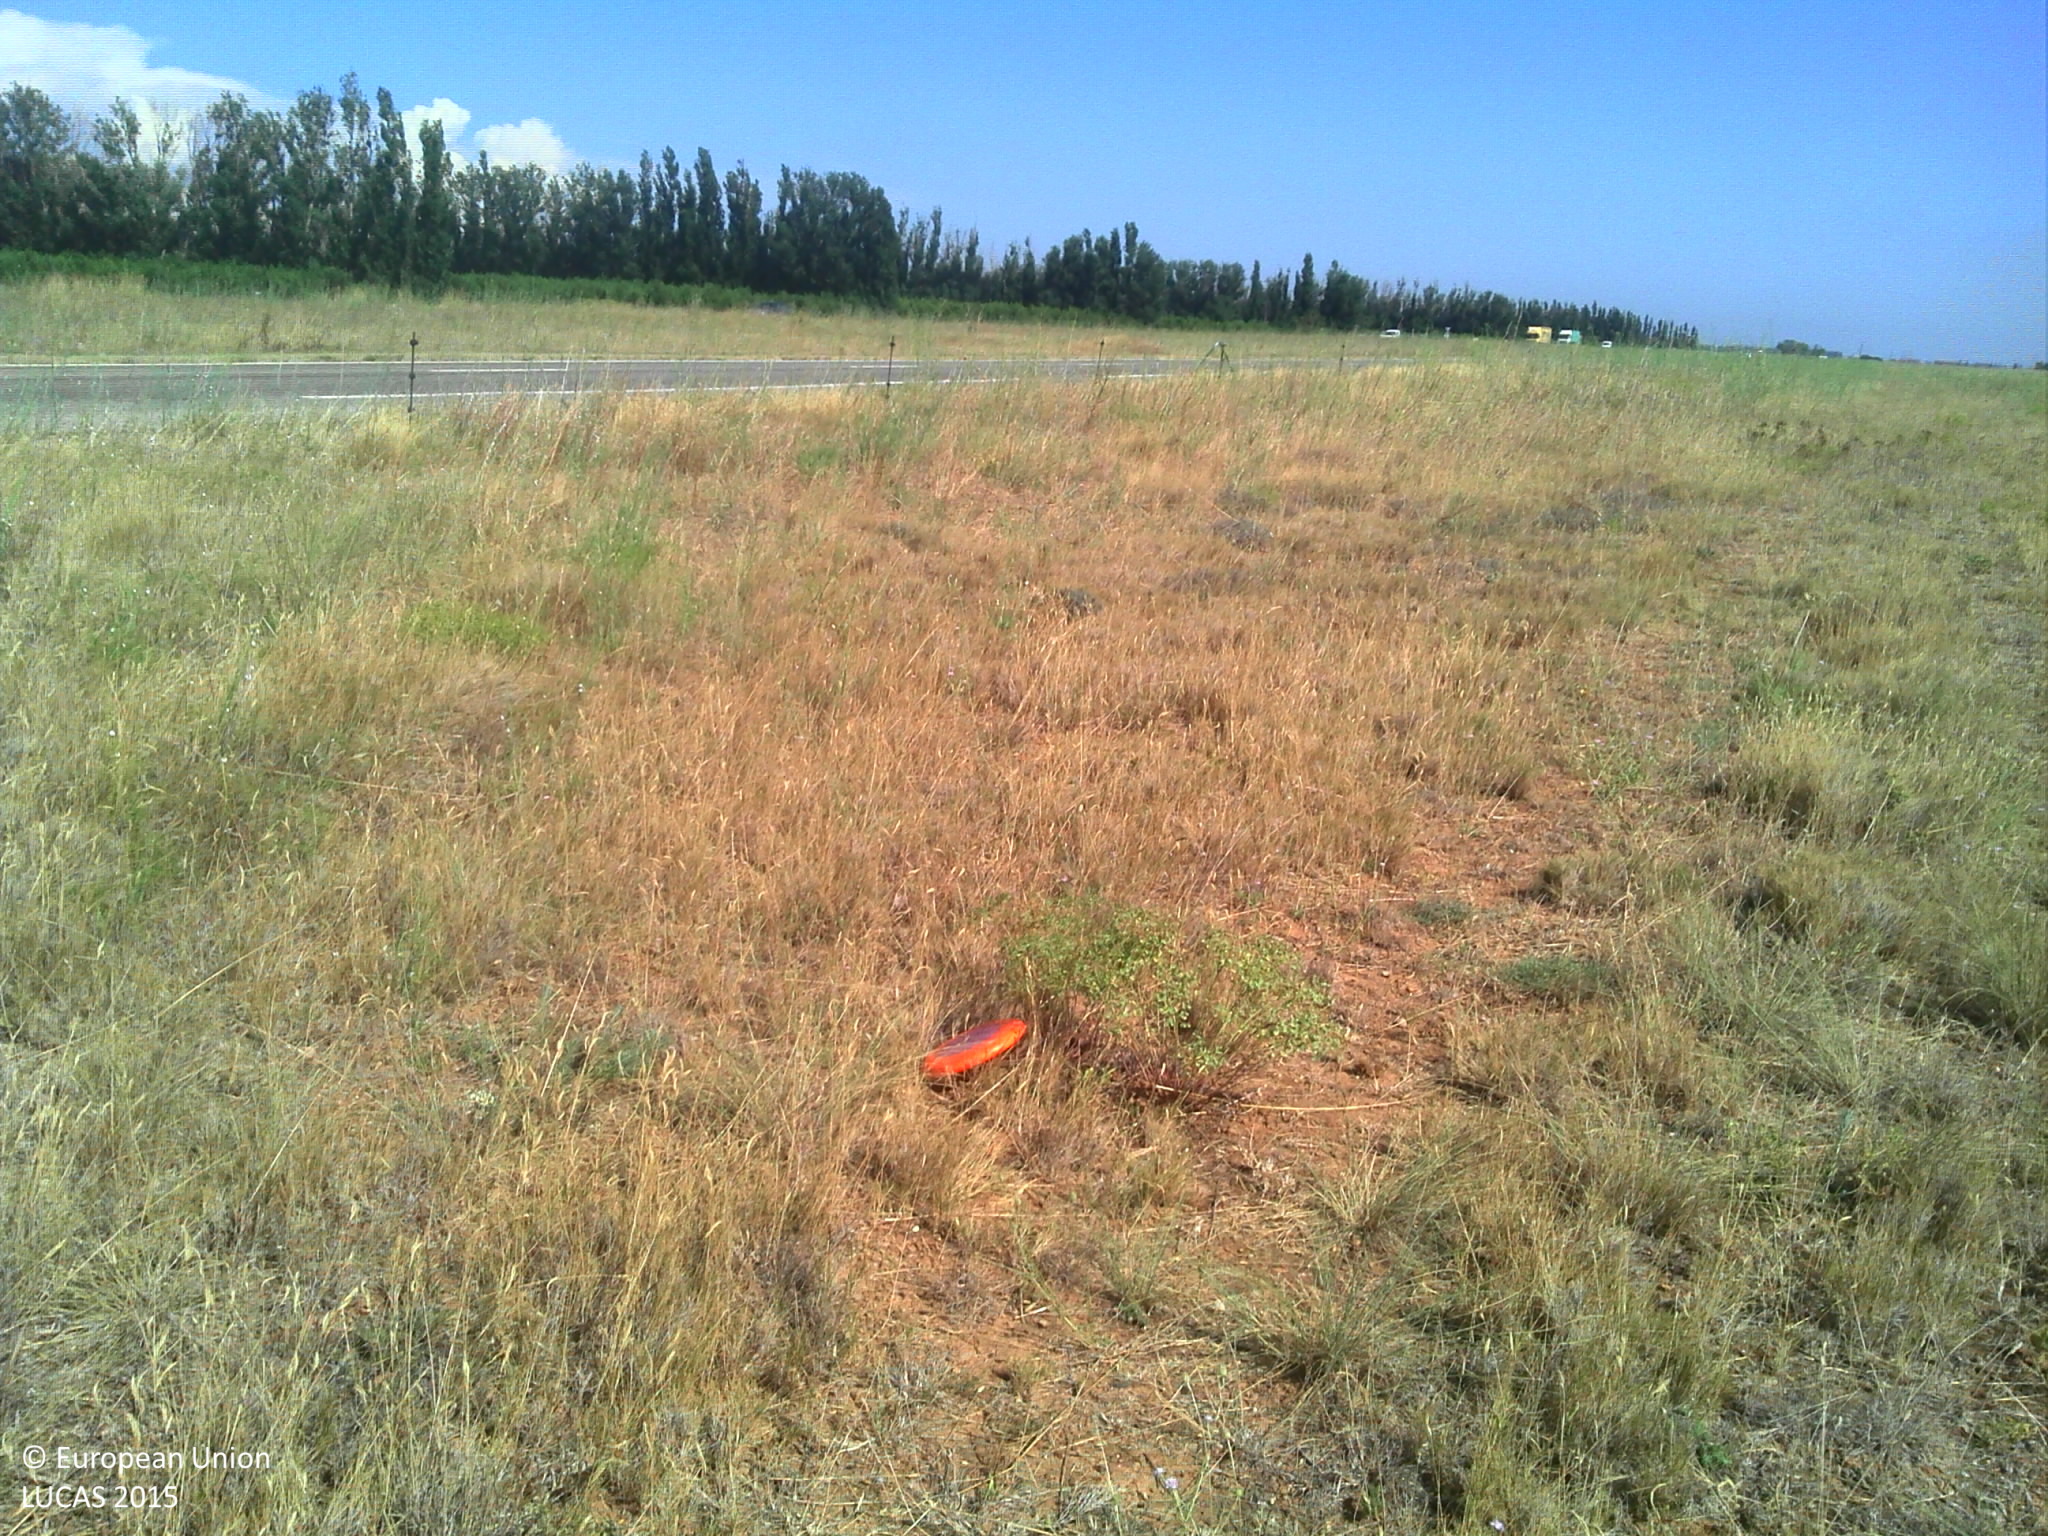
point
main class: Grassland
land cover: Grassland without tree/shrub cover
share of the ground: > 75 %
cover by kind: herbaceous plants 55 %, unconsolidated bare surface 45 %
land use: Agriculture (excluding fallow land and kitchen gardens)
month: July
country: FR
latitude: 43.5346
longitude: 4.8250
